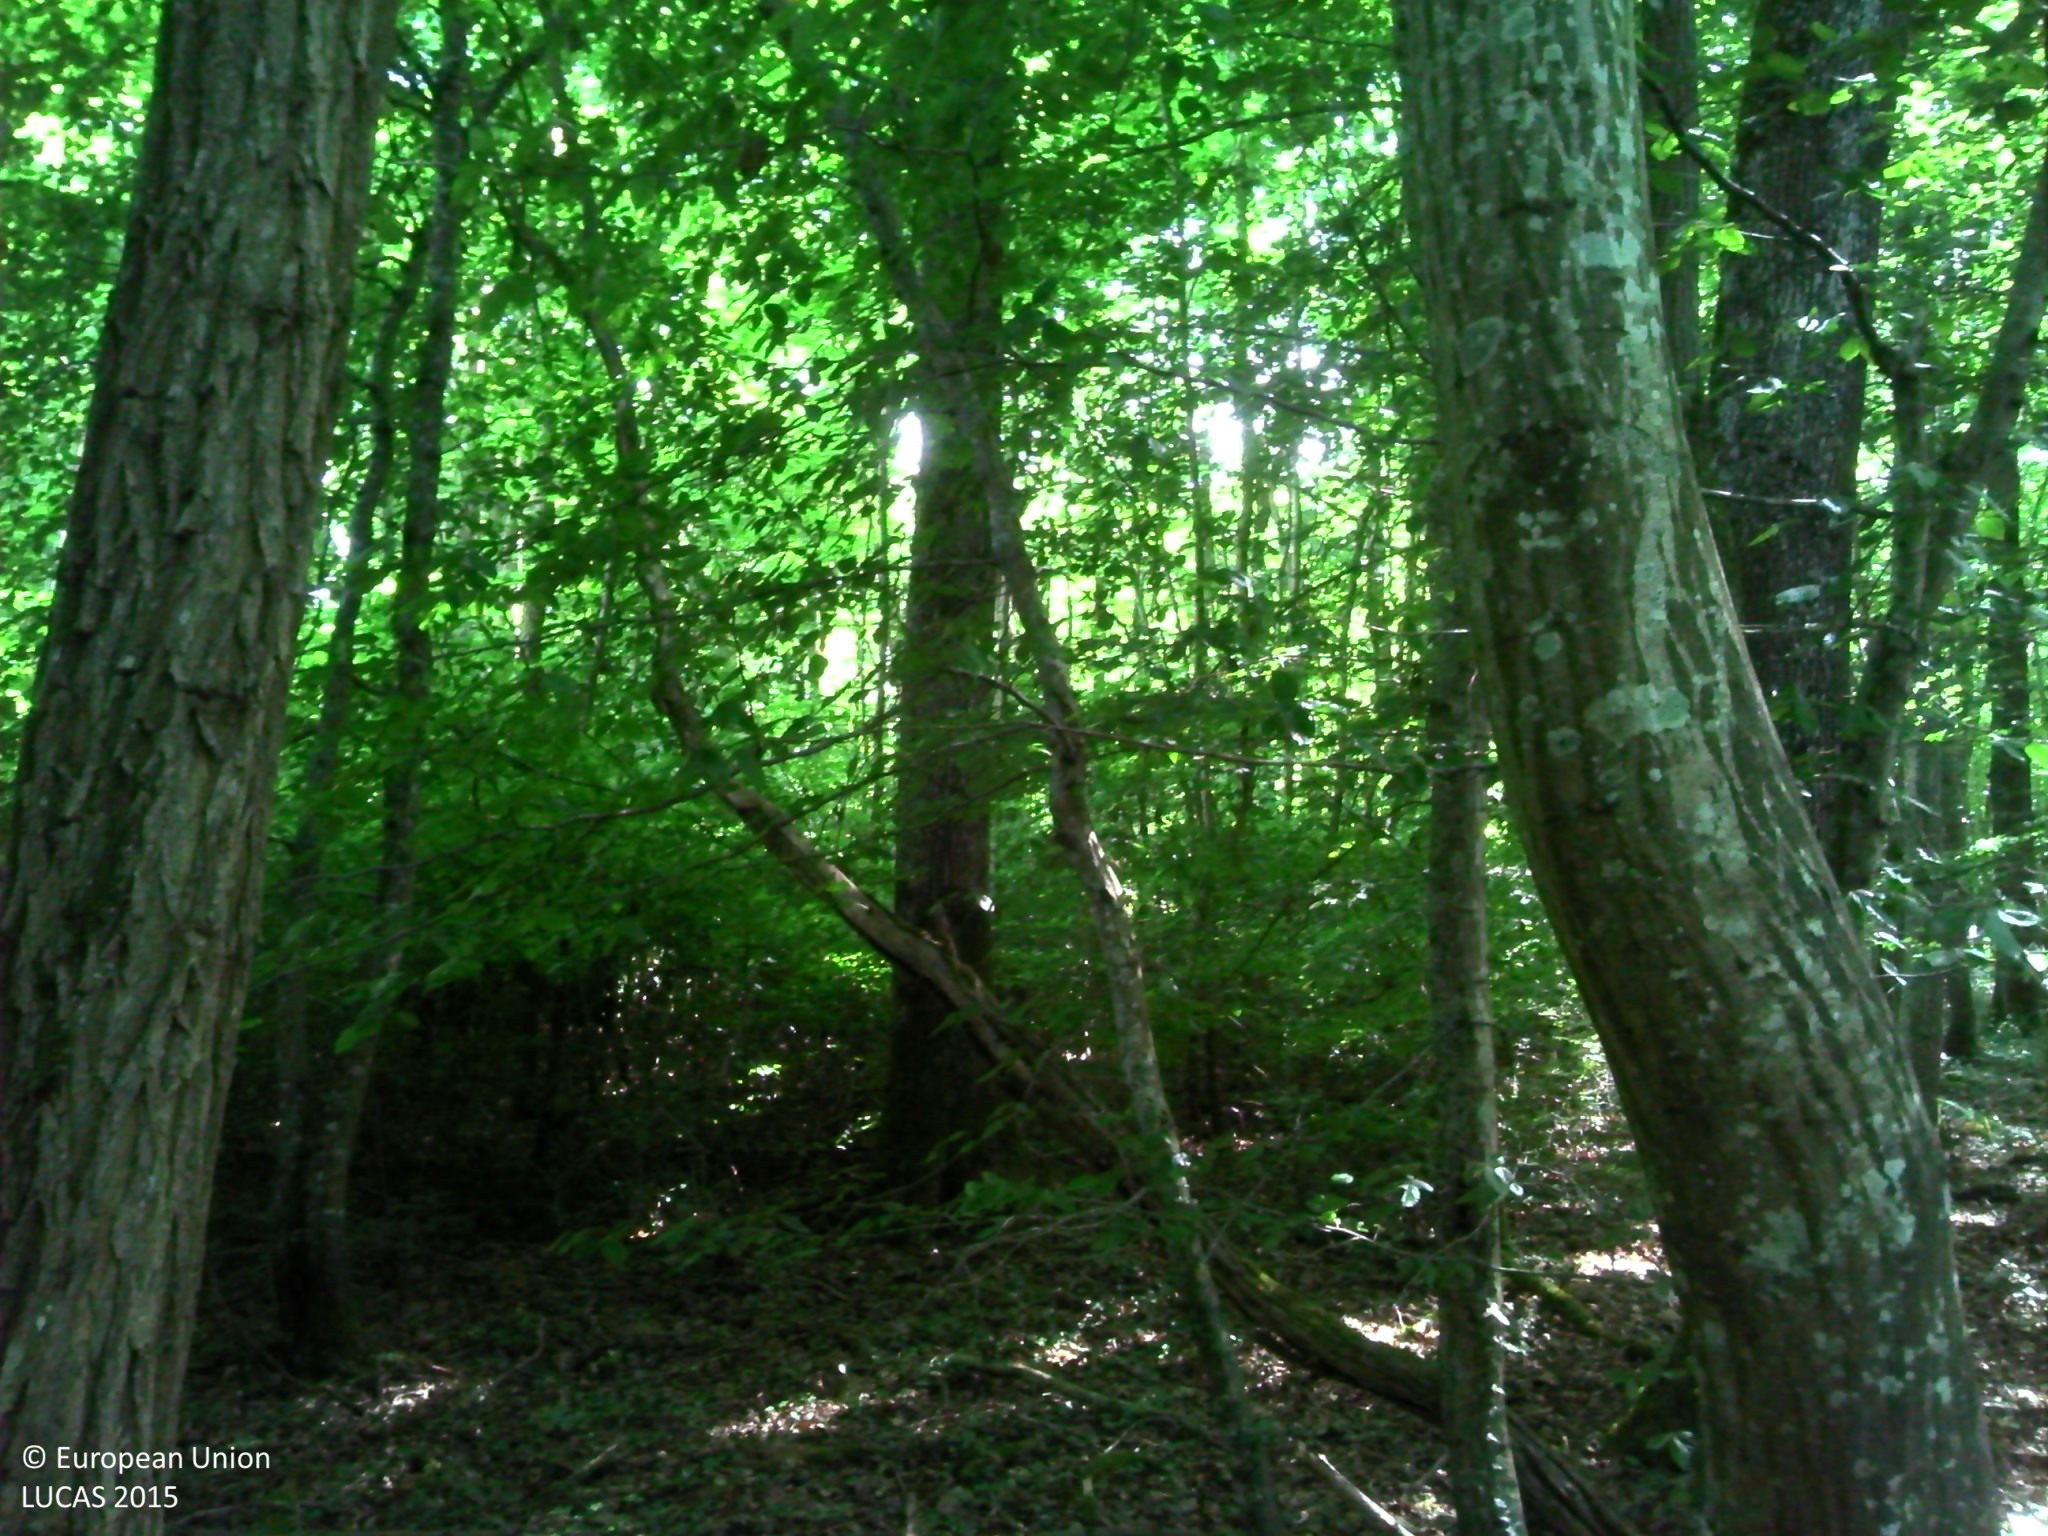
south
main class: Woodland
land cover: Broadleaved woodland
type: mesophytic deciduous forest
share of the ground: > 75 %
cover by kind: broadleaved forest trees 100 %
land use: Forestry
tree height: > 5 m
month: June
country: FR
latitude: 47.4904
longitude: 3.5058
